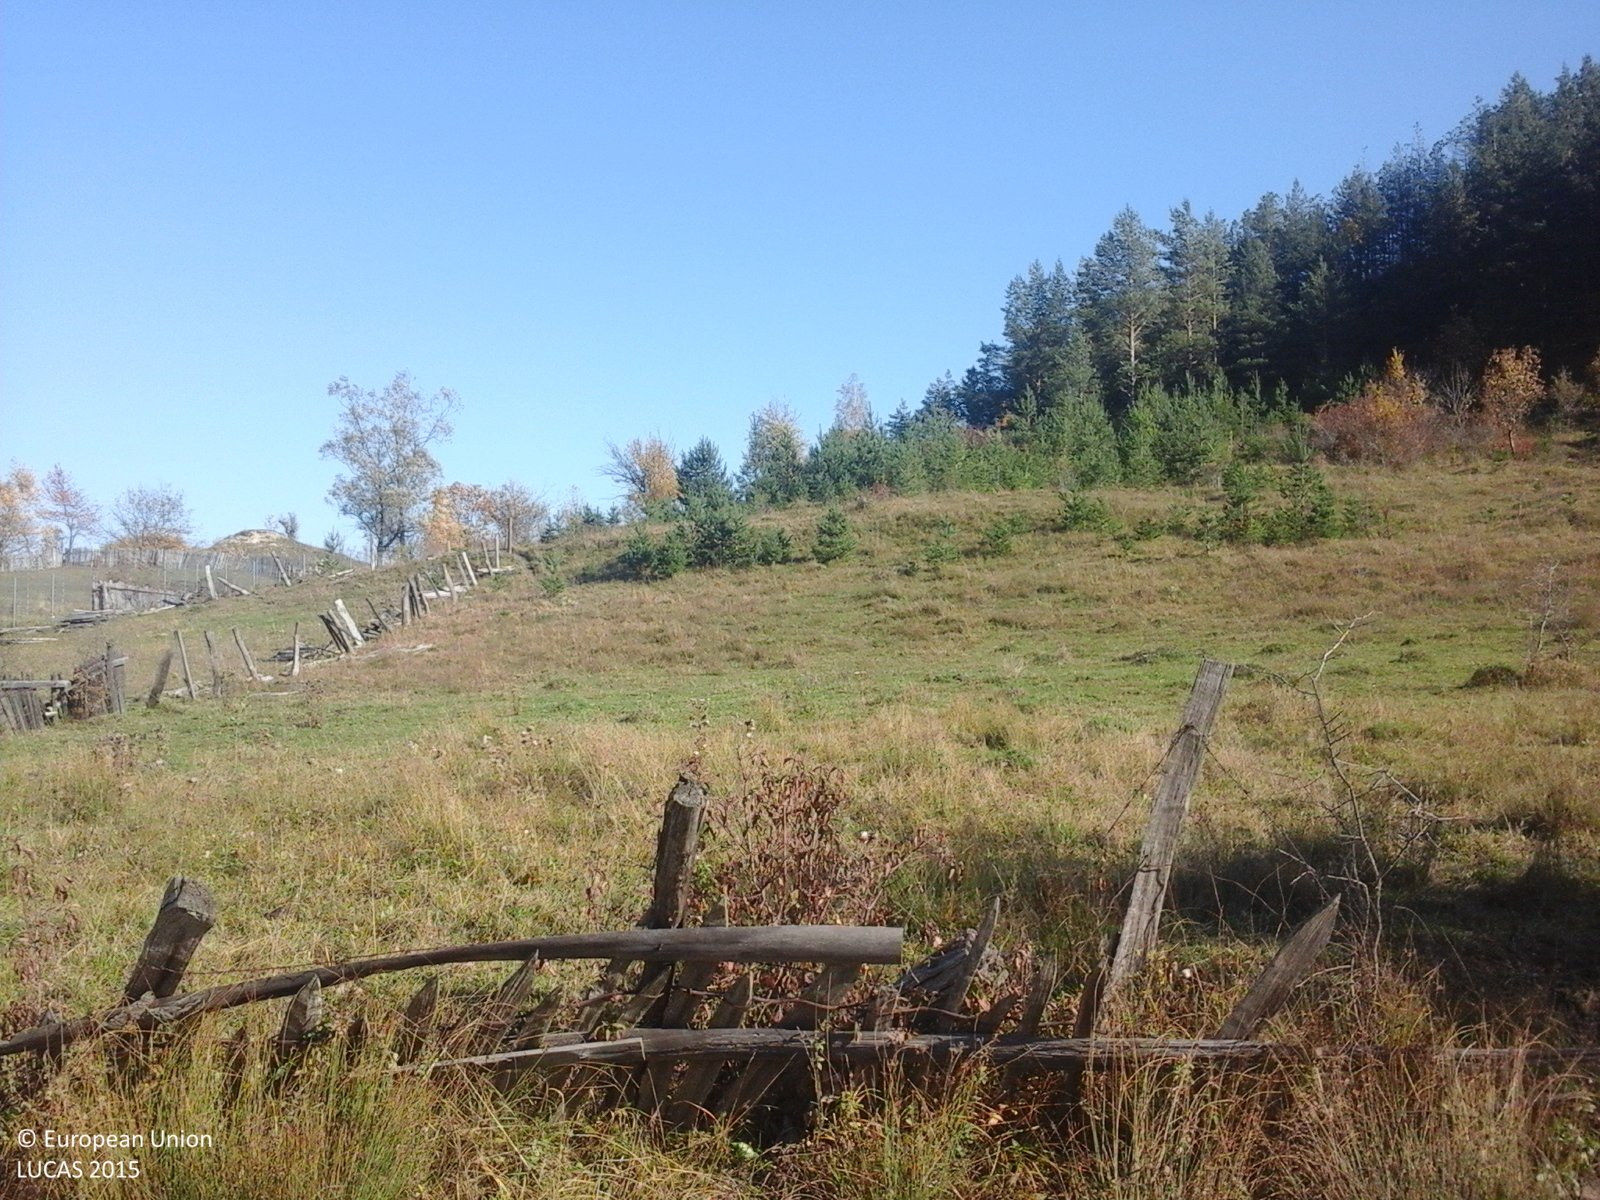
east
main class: Grassland
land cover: Grassland without tree/shrub cover
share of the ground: > 75 %
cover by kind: herbaceous plants 100 %
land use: Residential
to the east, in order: Grassland without tree/shrub cover; Fences; Grass margins; Paved roads, cycling and walking lanes; Grass margins; Electric lines; Grass margins; Fences; Grassland without tree/shrub cover; Grassland with sparse tree/shrub cover; Fences; Grassland with sparse tree/shrub cover; Grassland without tree/shrub cover; Other fruit trees and berries; Fences; Grassland without tree/shrub cover
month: October
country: RO
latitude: 45.9301
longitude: 26.6800
